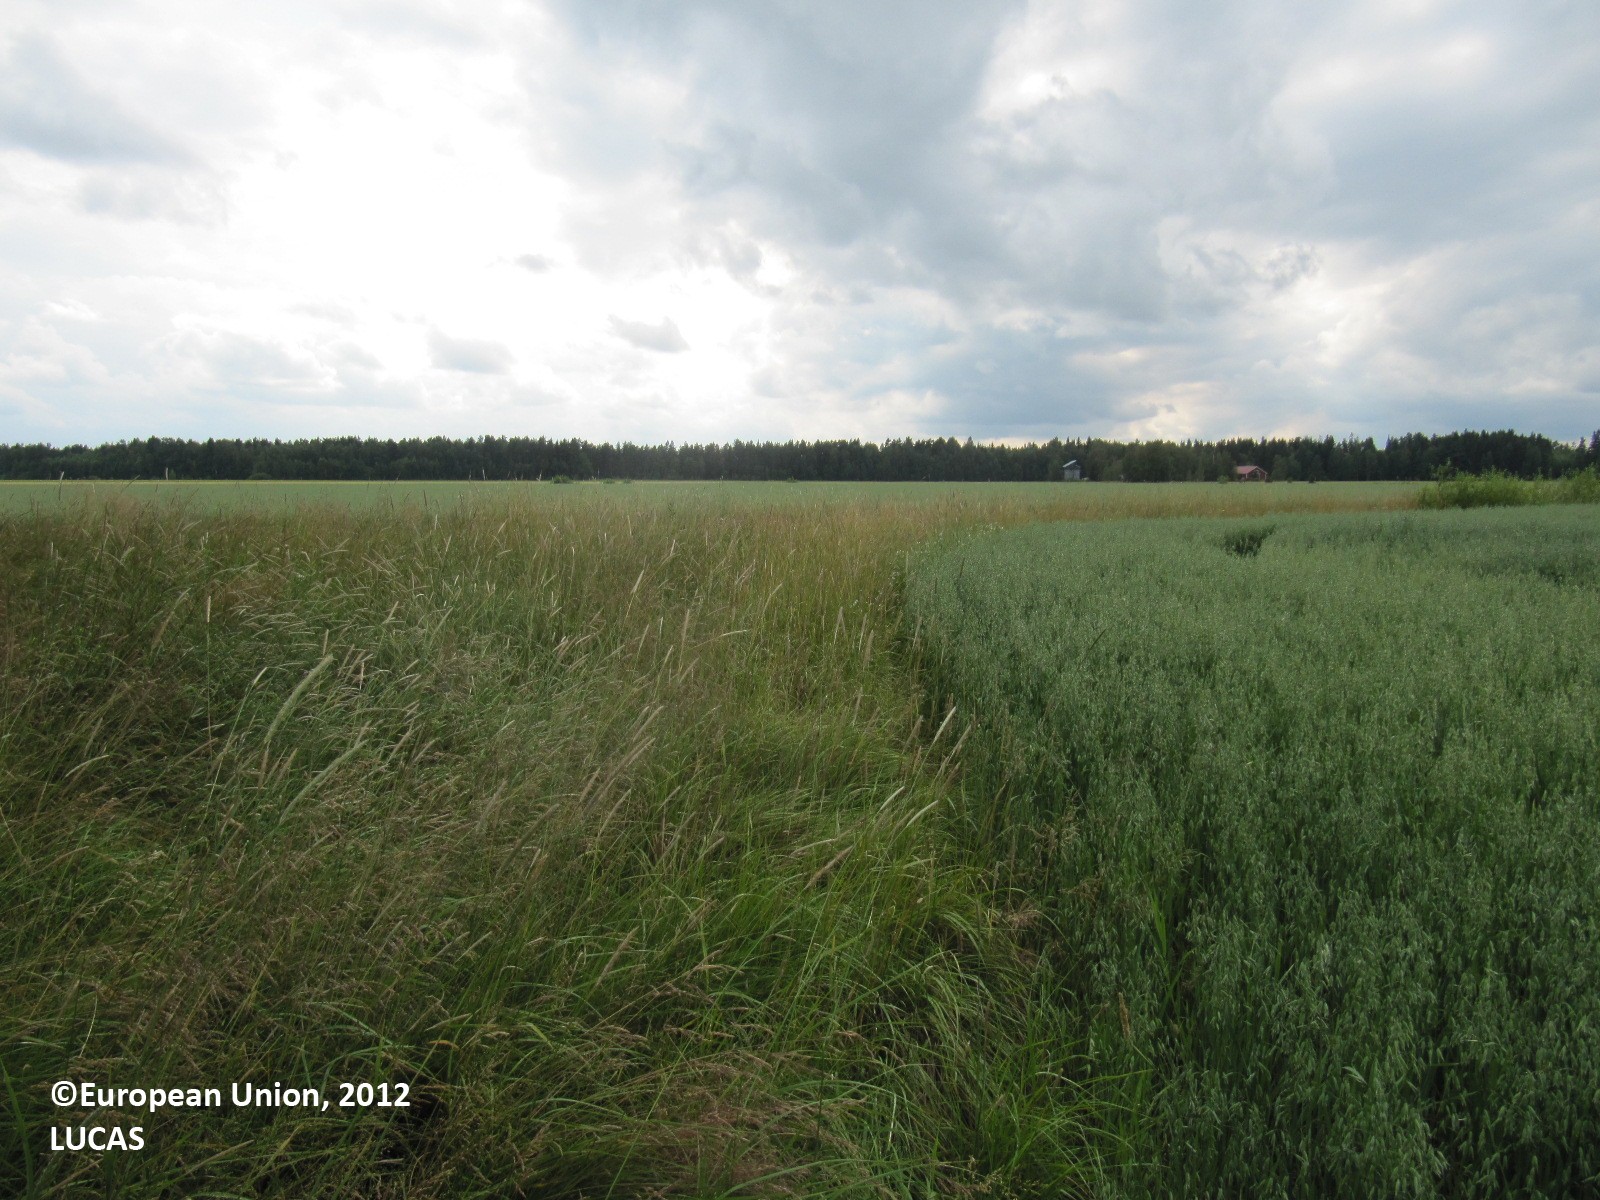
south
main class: Cropland
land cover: Oats
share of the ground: > 75 %
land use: Agriculture (excluding fallow land and kitchen gardens)
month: July
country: FI
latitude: 60.6271
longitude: 23.2965
